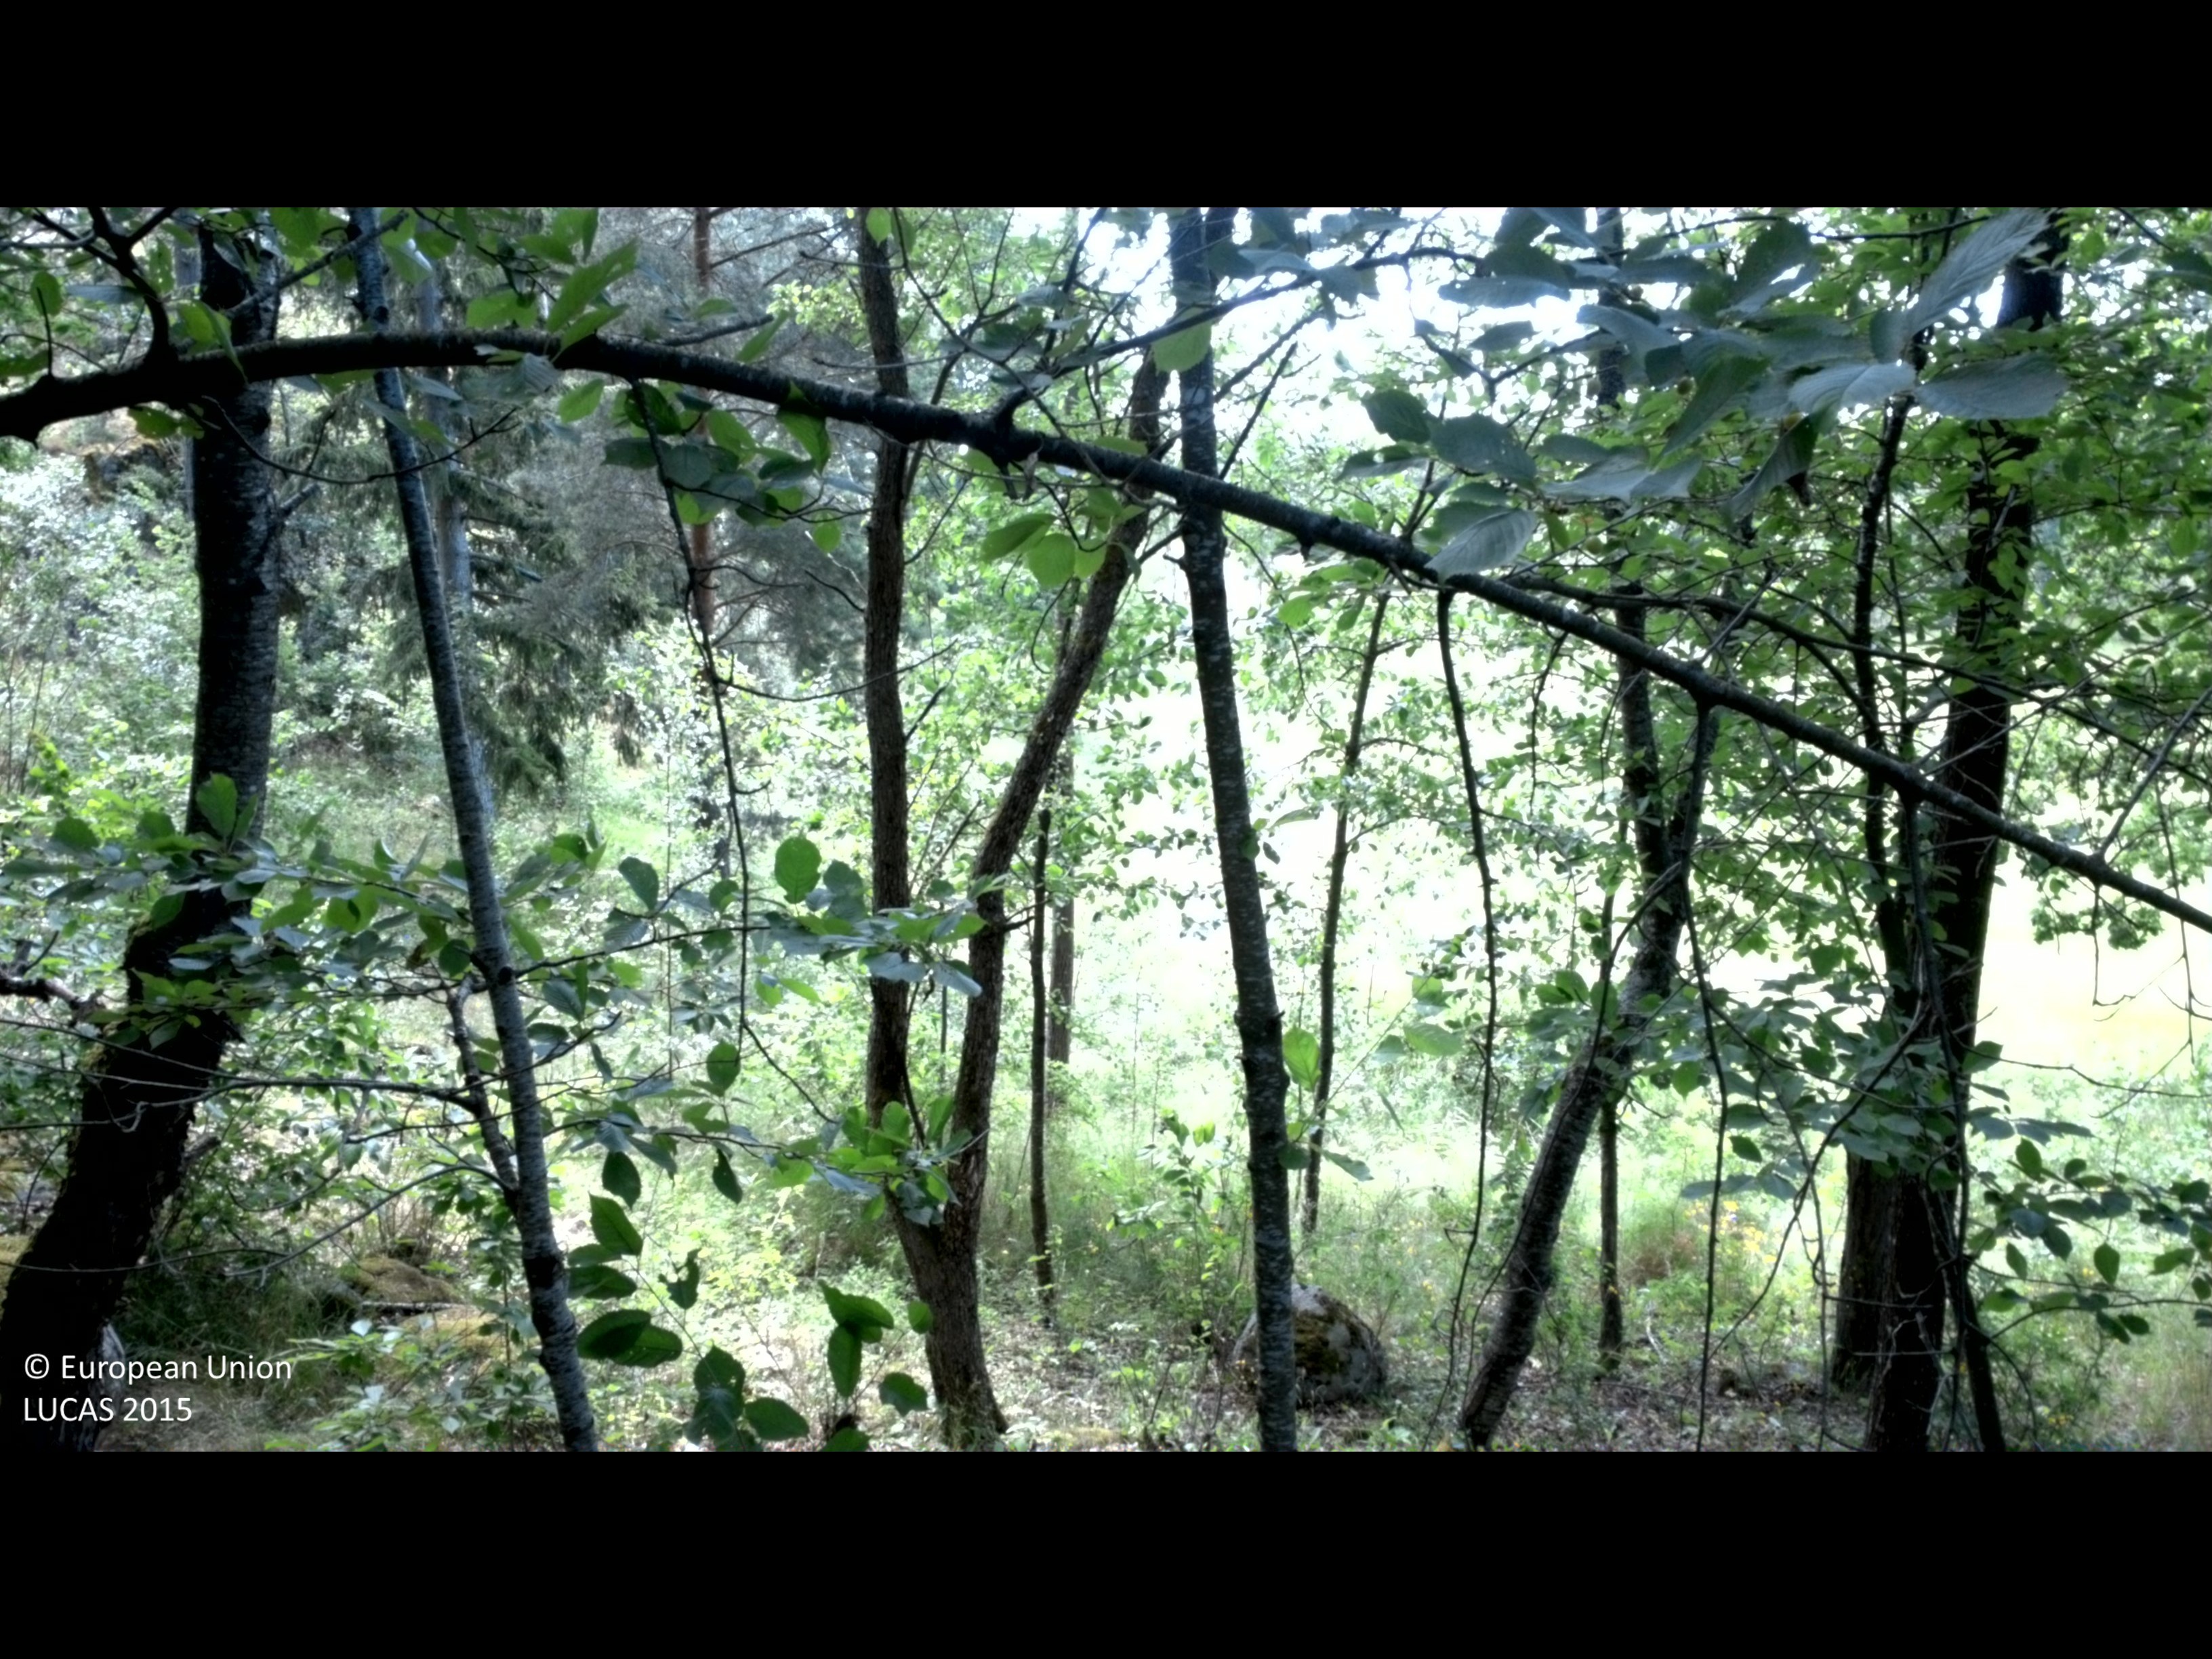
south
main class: Woodland
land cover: Other mixed woodland
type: boreal forest
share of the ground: 50 - 75 %
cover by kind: broadleaved forest trees 40 %, coniferous forest trees 25 %, shrubs 20 %, herbaceous plants 15 %
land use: Forestry
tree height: > 5 m
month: July
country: SE
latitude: 58.2857
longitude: 16.3581
